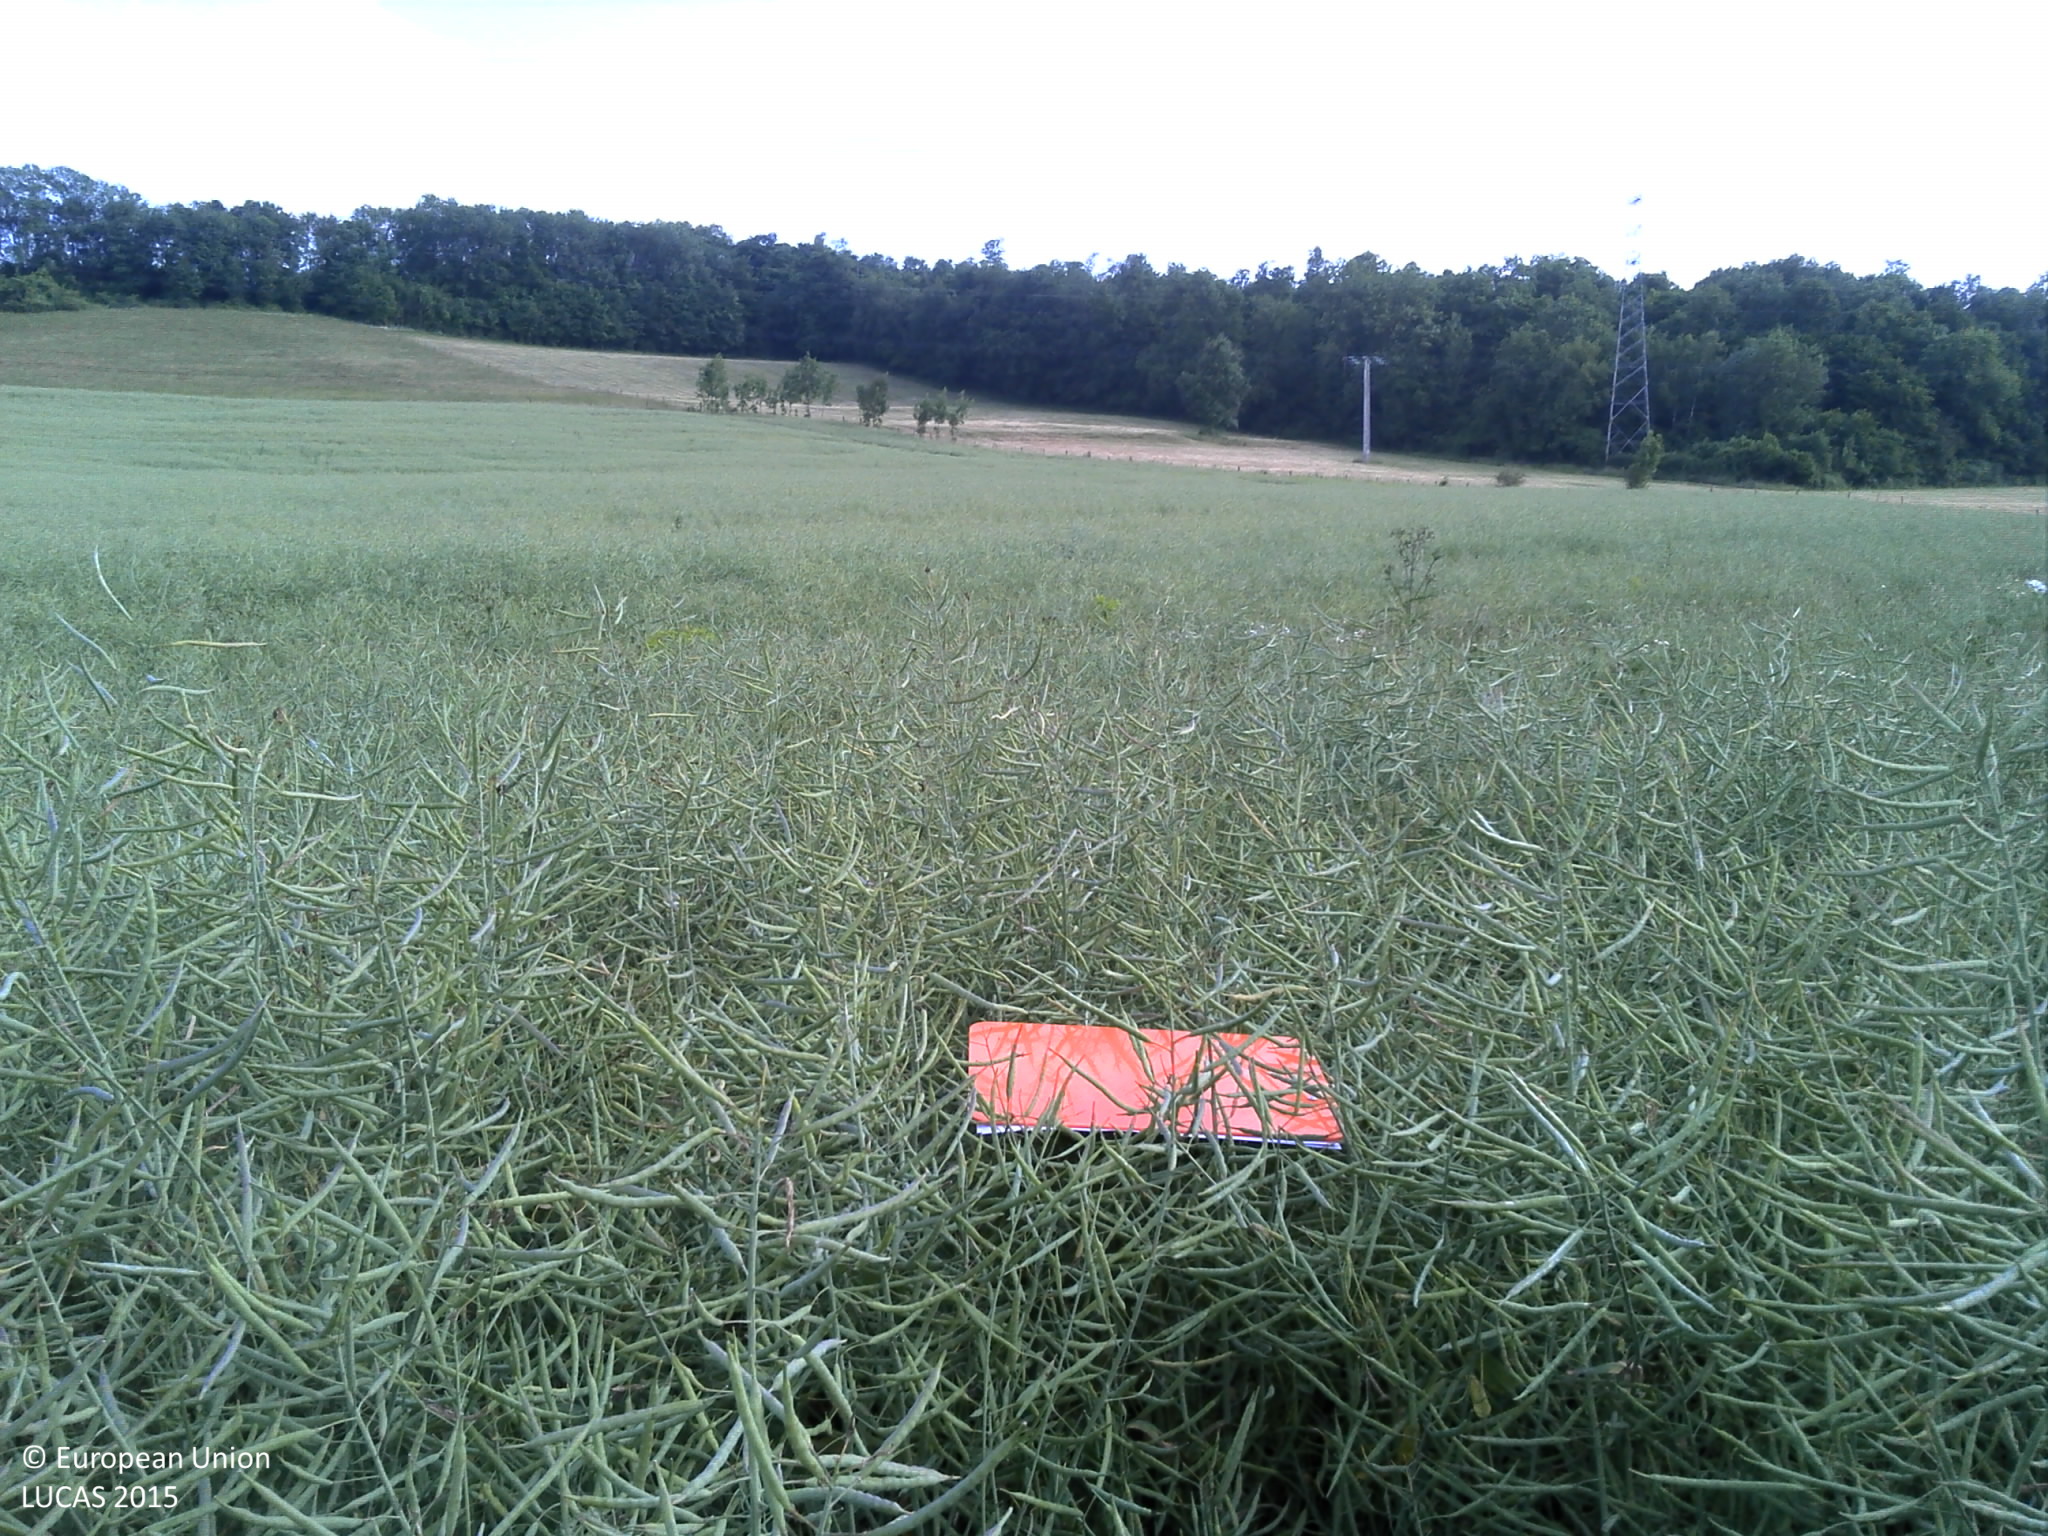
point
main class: Cropland
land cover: Rape and turnip rape
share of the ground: > 75 %
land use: Agriculture (excluding fallow land and kitchen gardens)
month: June
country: FR
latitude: 49.1497
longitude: 6.2295
